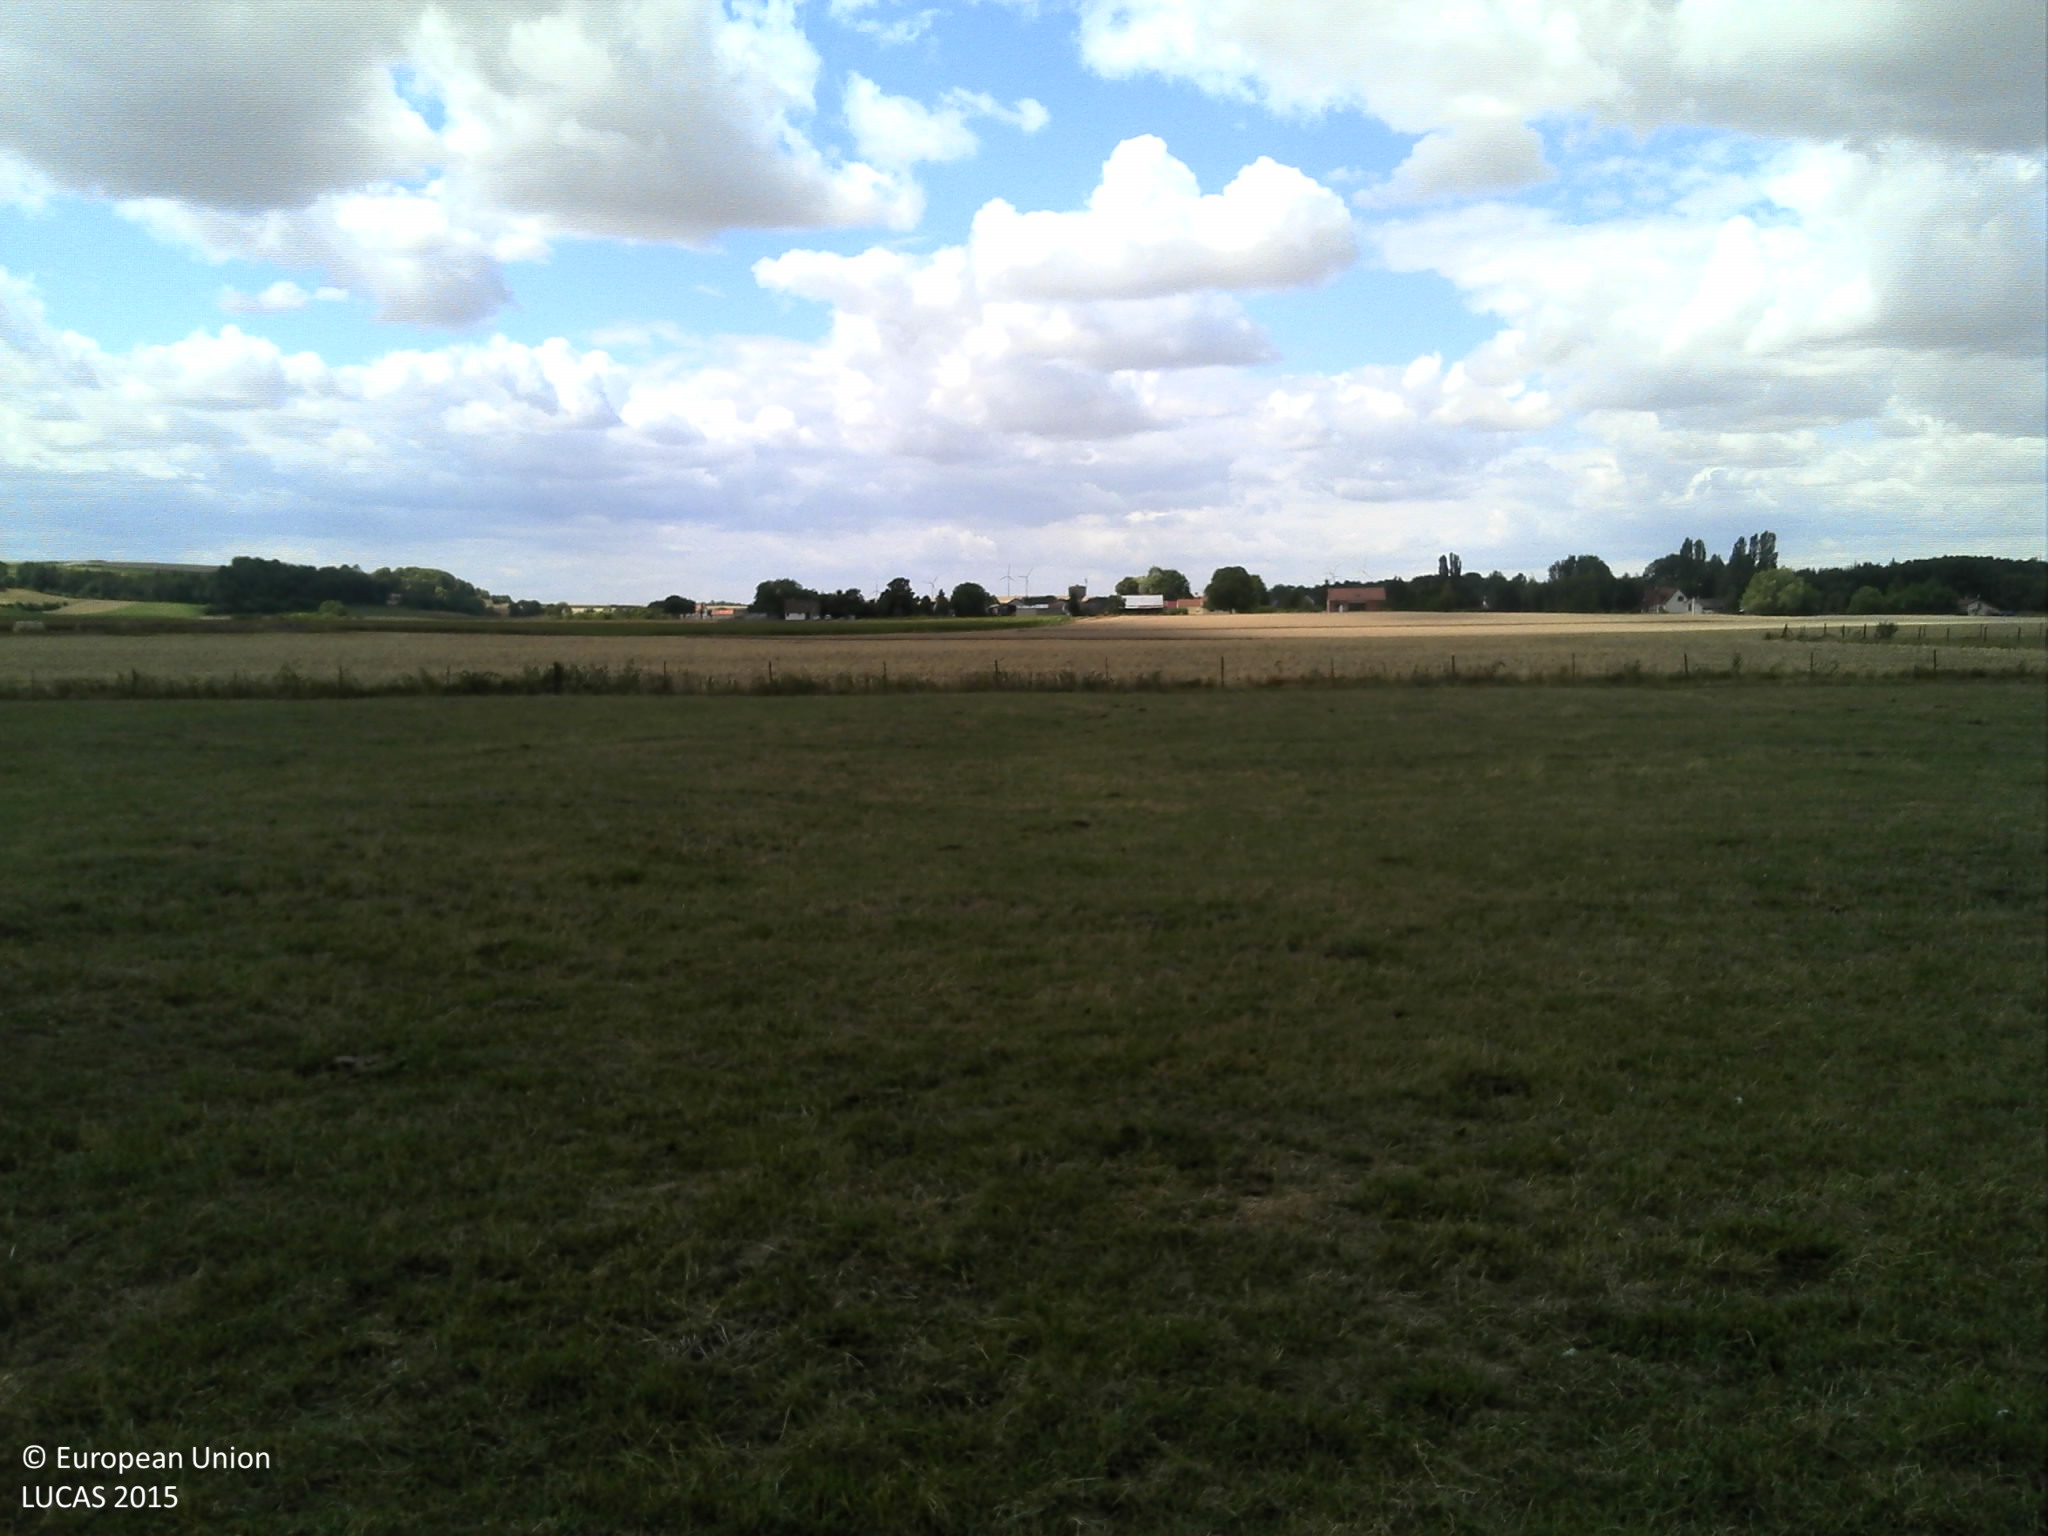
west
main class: Grassland
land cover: Grassland without tree/shrub cover
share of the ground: > 75 %
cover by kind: herbaceous plants 100 %
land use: Agriculture (excluding fallow land and kitchen gardens)
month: July
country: FR
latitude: 49.3566
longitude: 4.6687
